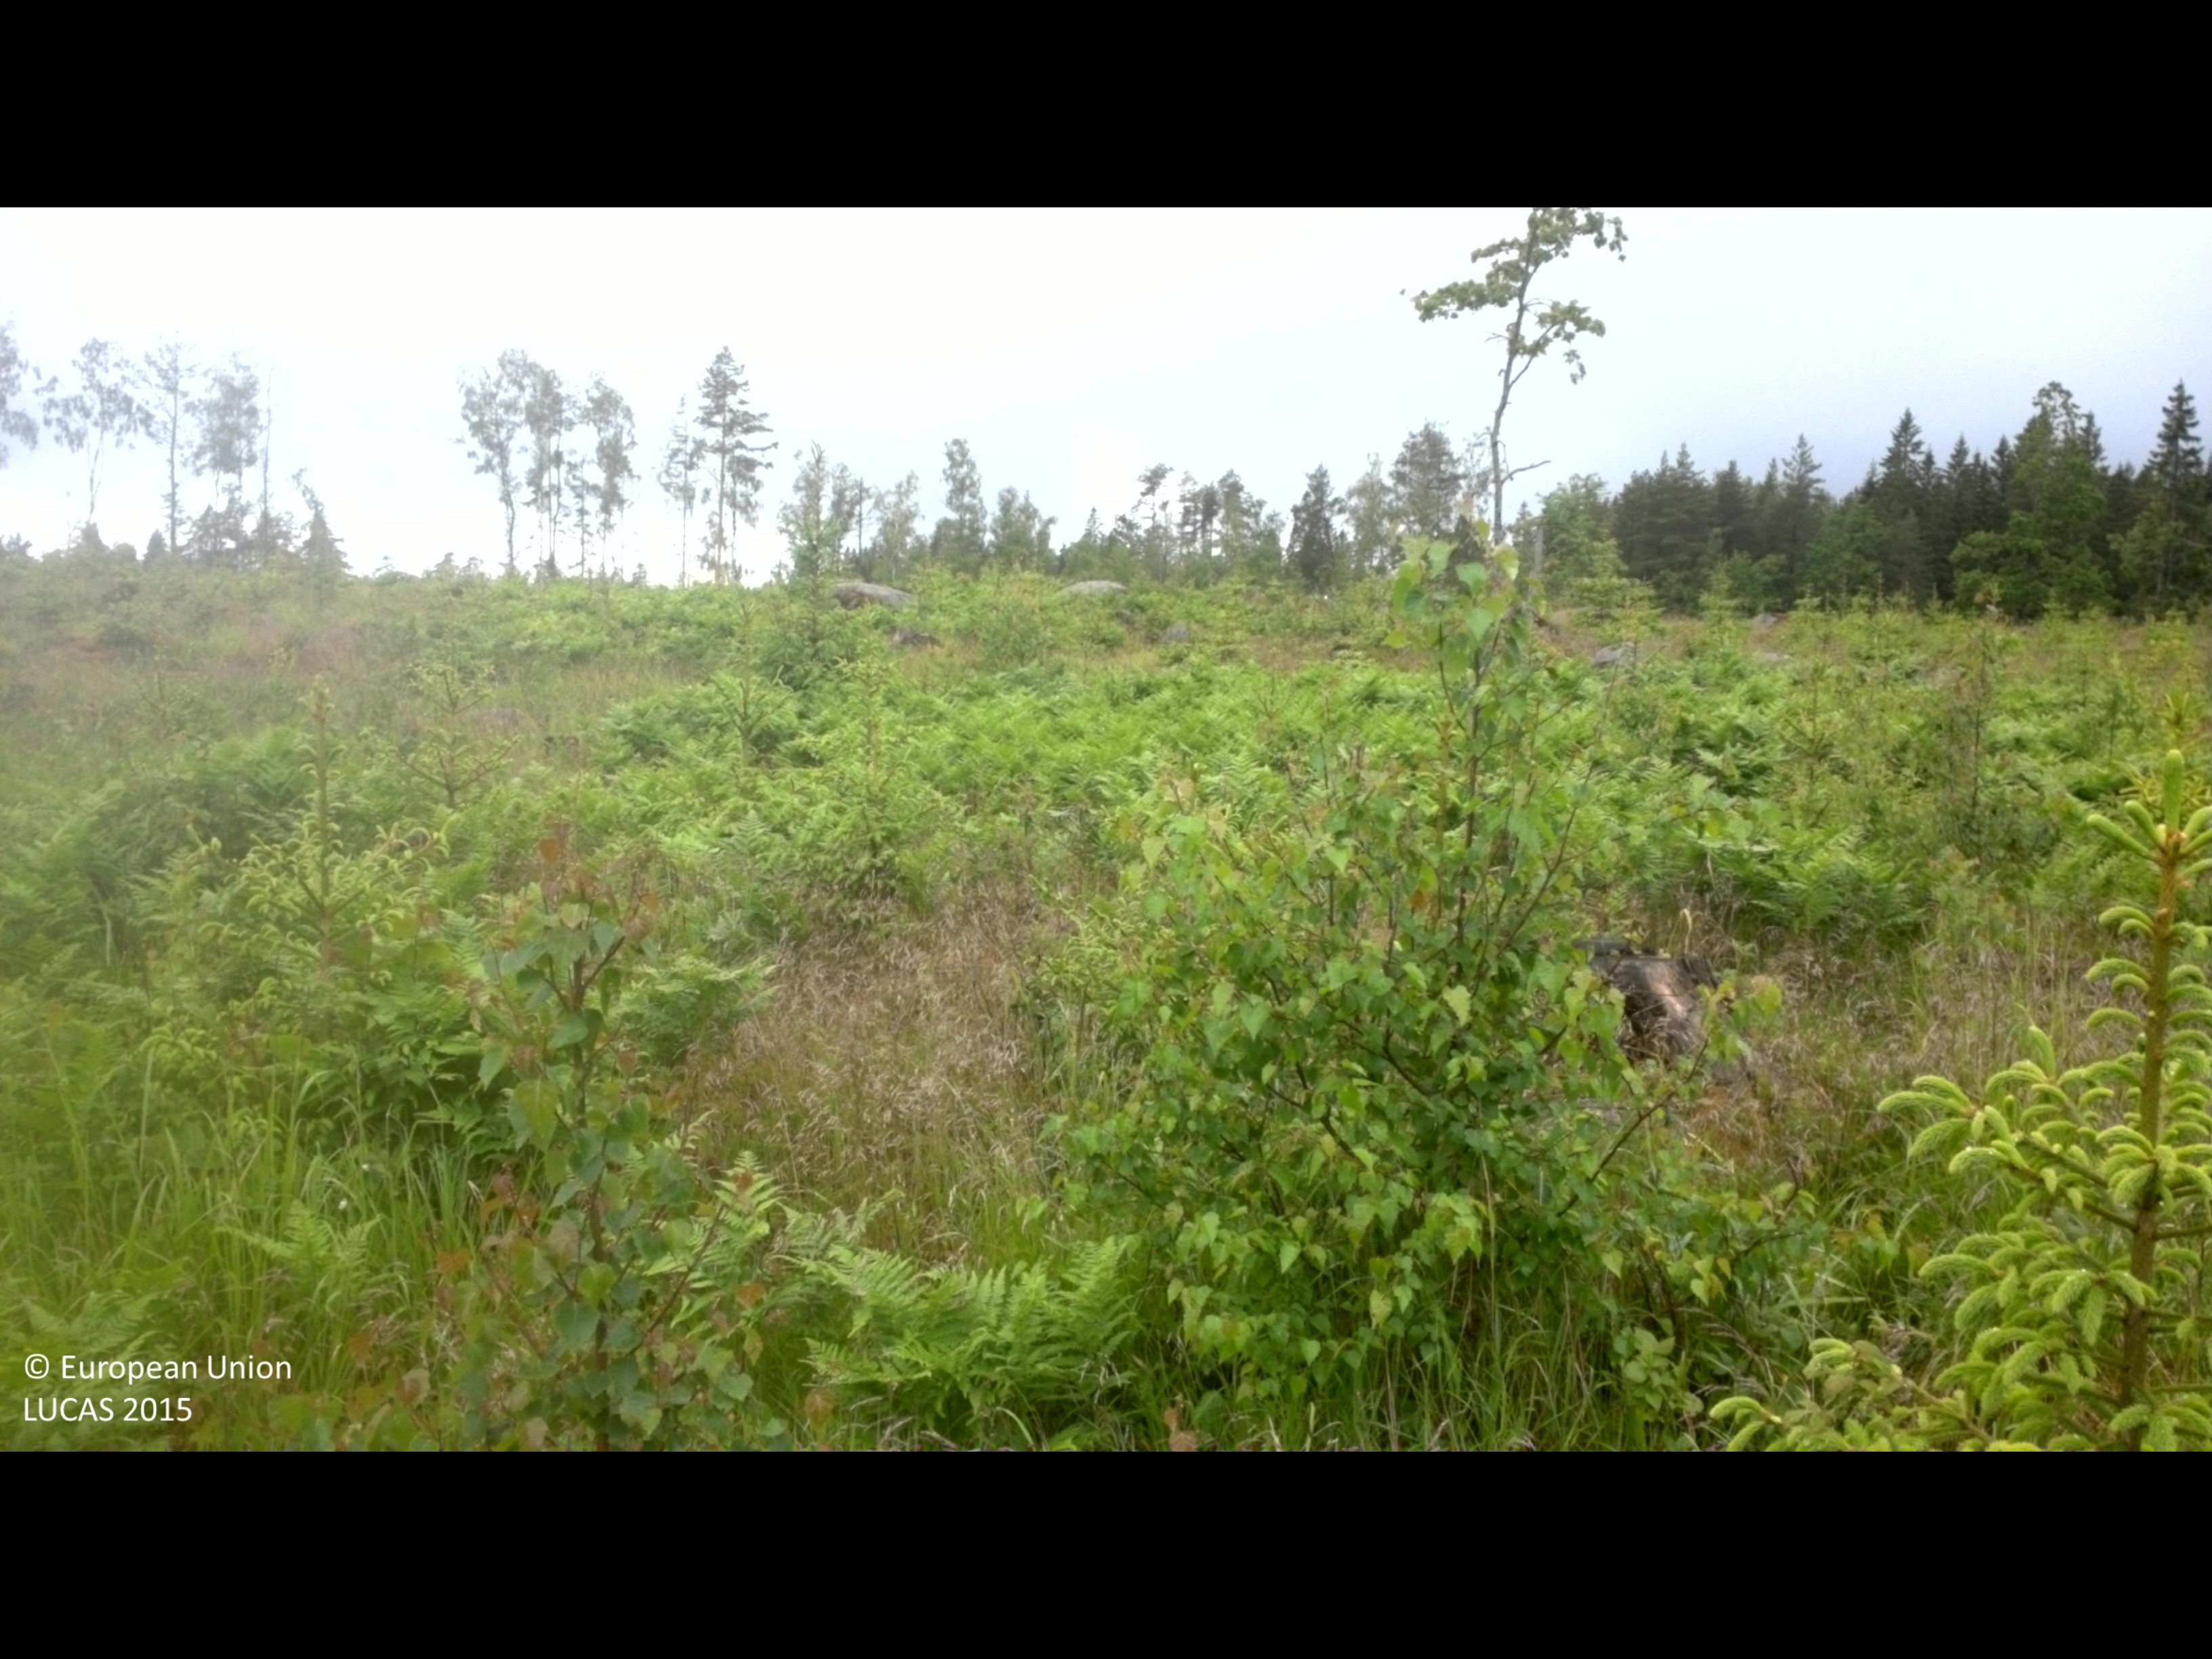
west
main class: Woodland
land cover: Other mixed woodland
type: boreal forest
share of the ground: 25 - 50 %
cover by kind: herbaceous plants 40 %, broadleaved forest trees 25 %, coniferous forest trees 20 %, shrubs 10 %, consolidated bare surface 5 %
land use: Forestry
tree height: < 5 m
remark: Clear cut
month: June
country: SE
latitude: 58.0398
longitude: 16.2131
